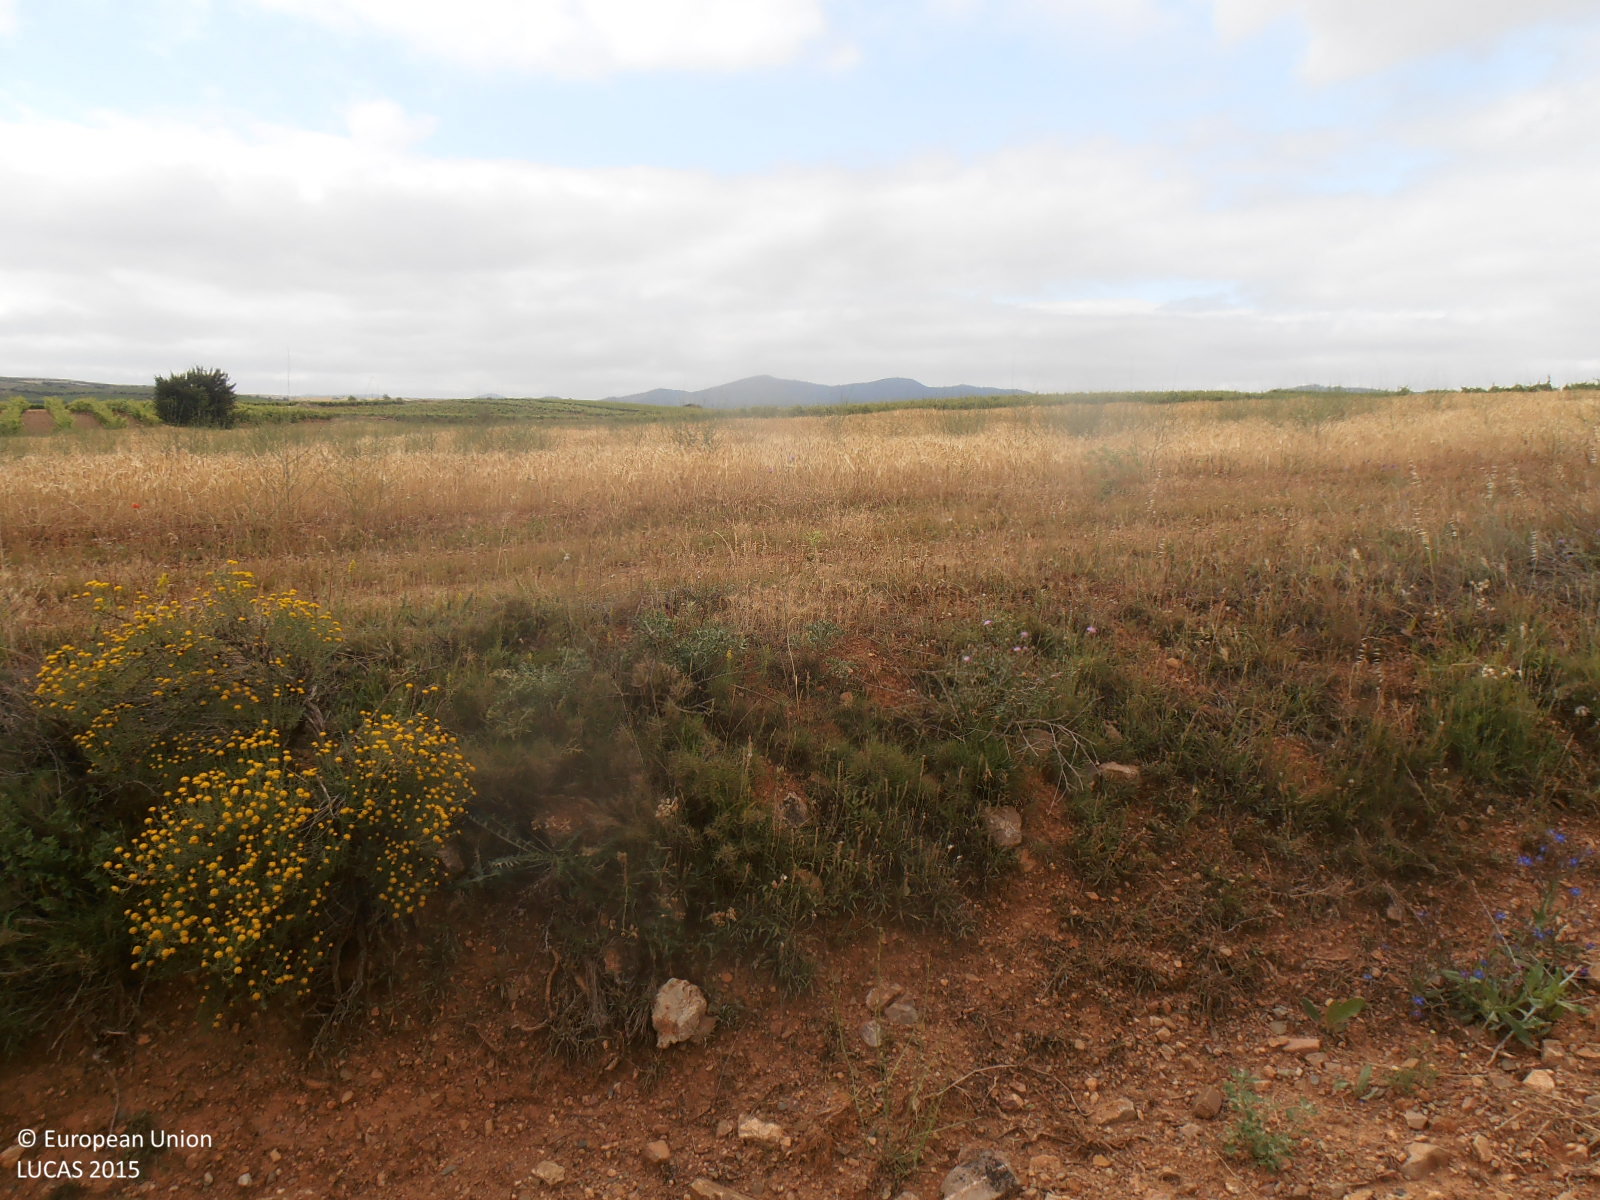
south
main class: Cropland
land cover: Vineyards
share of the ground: 25 - 50 %
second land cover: Other bare soil
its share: > 75 %
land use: Agriculture (excluding fallow land and kitchen gardens)
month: June
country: ES
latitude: 41.3033
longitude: -1.1880
